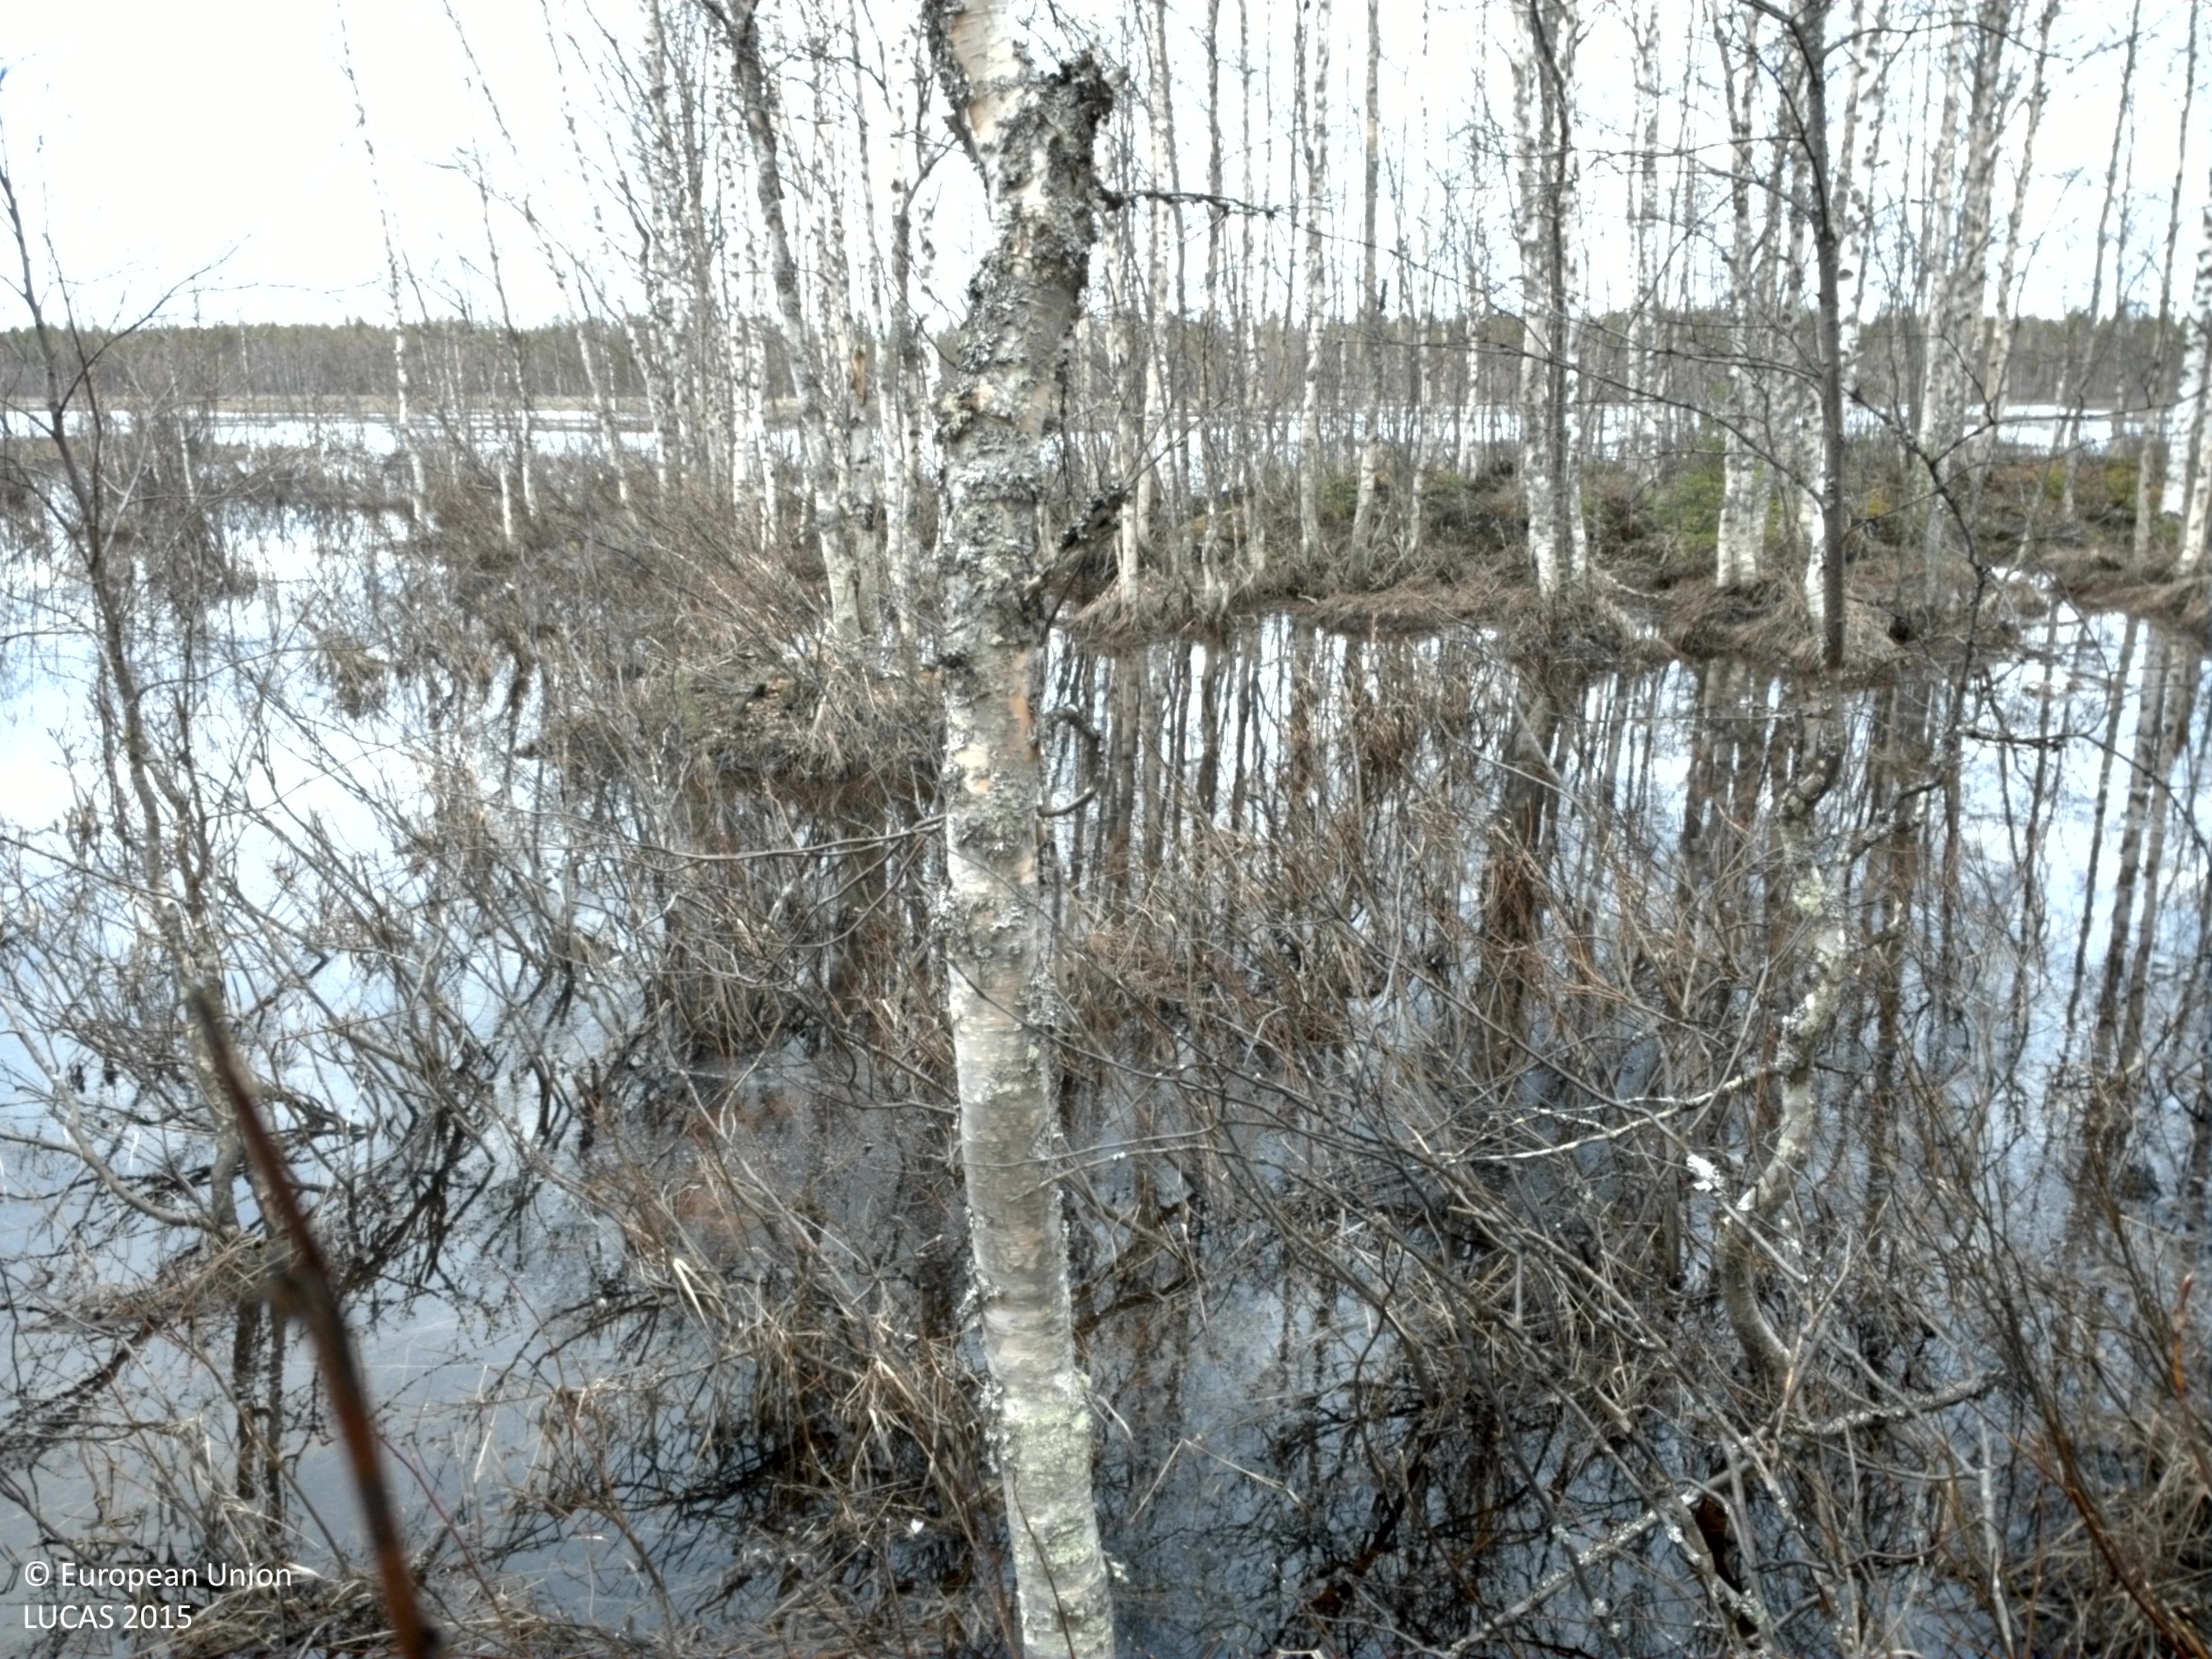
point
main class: Woodland
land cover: Broadleaved woodland
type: mire and swamp forests
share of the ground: 50 - 75 %
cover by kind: broadleaved forest trees 60 %, shrubs 15 %, herbaceous plants 10 %
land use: Semi-natural and natural areas not in use
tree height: > 5 m
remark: Temporary flooded
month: May
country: SE
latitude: 65.8939
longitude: 23.3086
